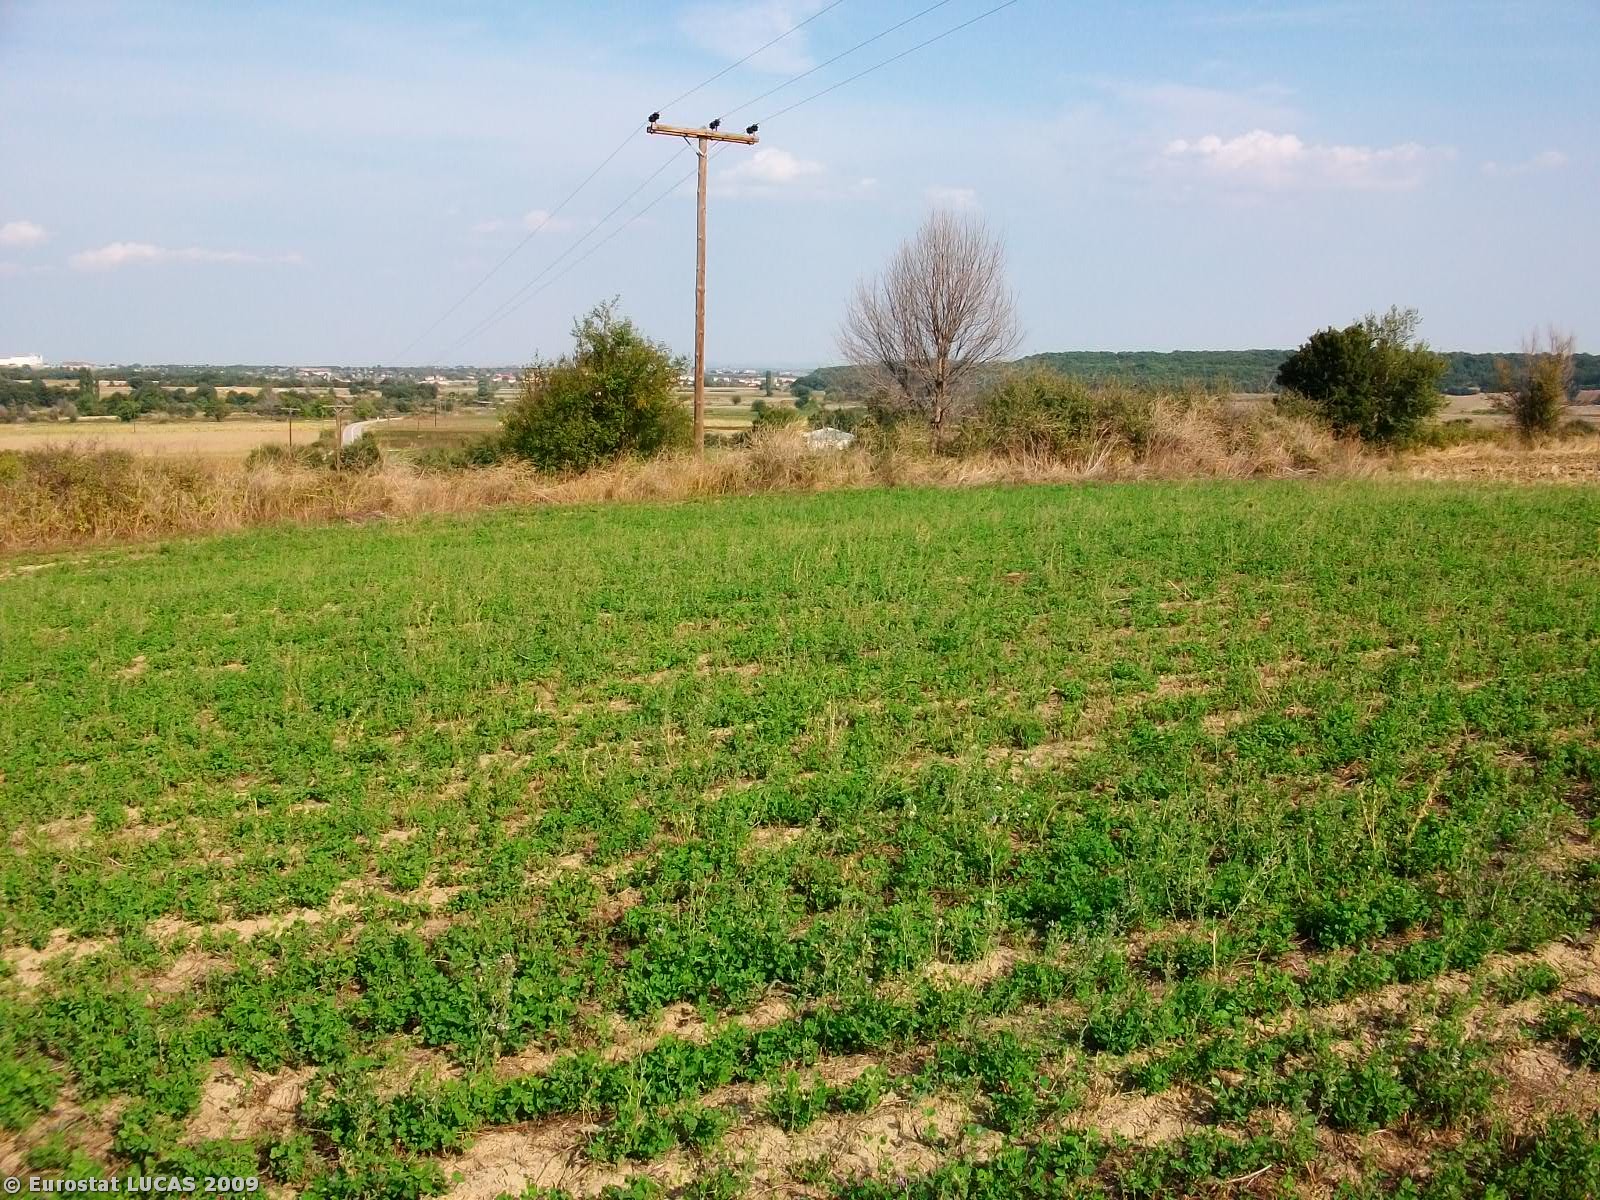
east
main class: Cropland
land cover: Lucerne
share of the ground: 50 - 75 %
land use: Agriculture (excluding fallow land and kitchen gardens)
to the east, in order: Lucerne; Abandoned hedges; Lucerne; Abandoned hedges; Lucerne; Electric lines; Lucerne; Abandoned hedges; Lucerne; Grassland without tree/shrub cover
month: September
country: GR
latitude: 41.0225
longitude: 26.2278
